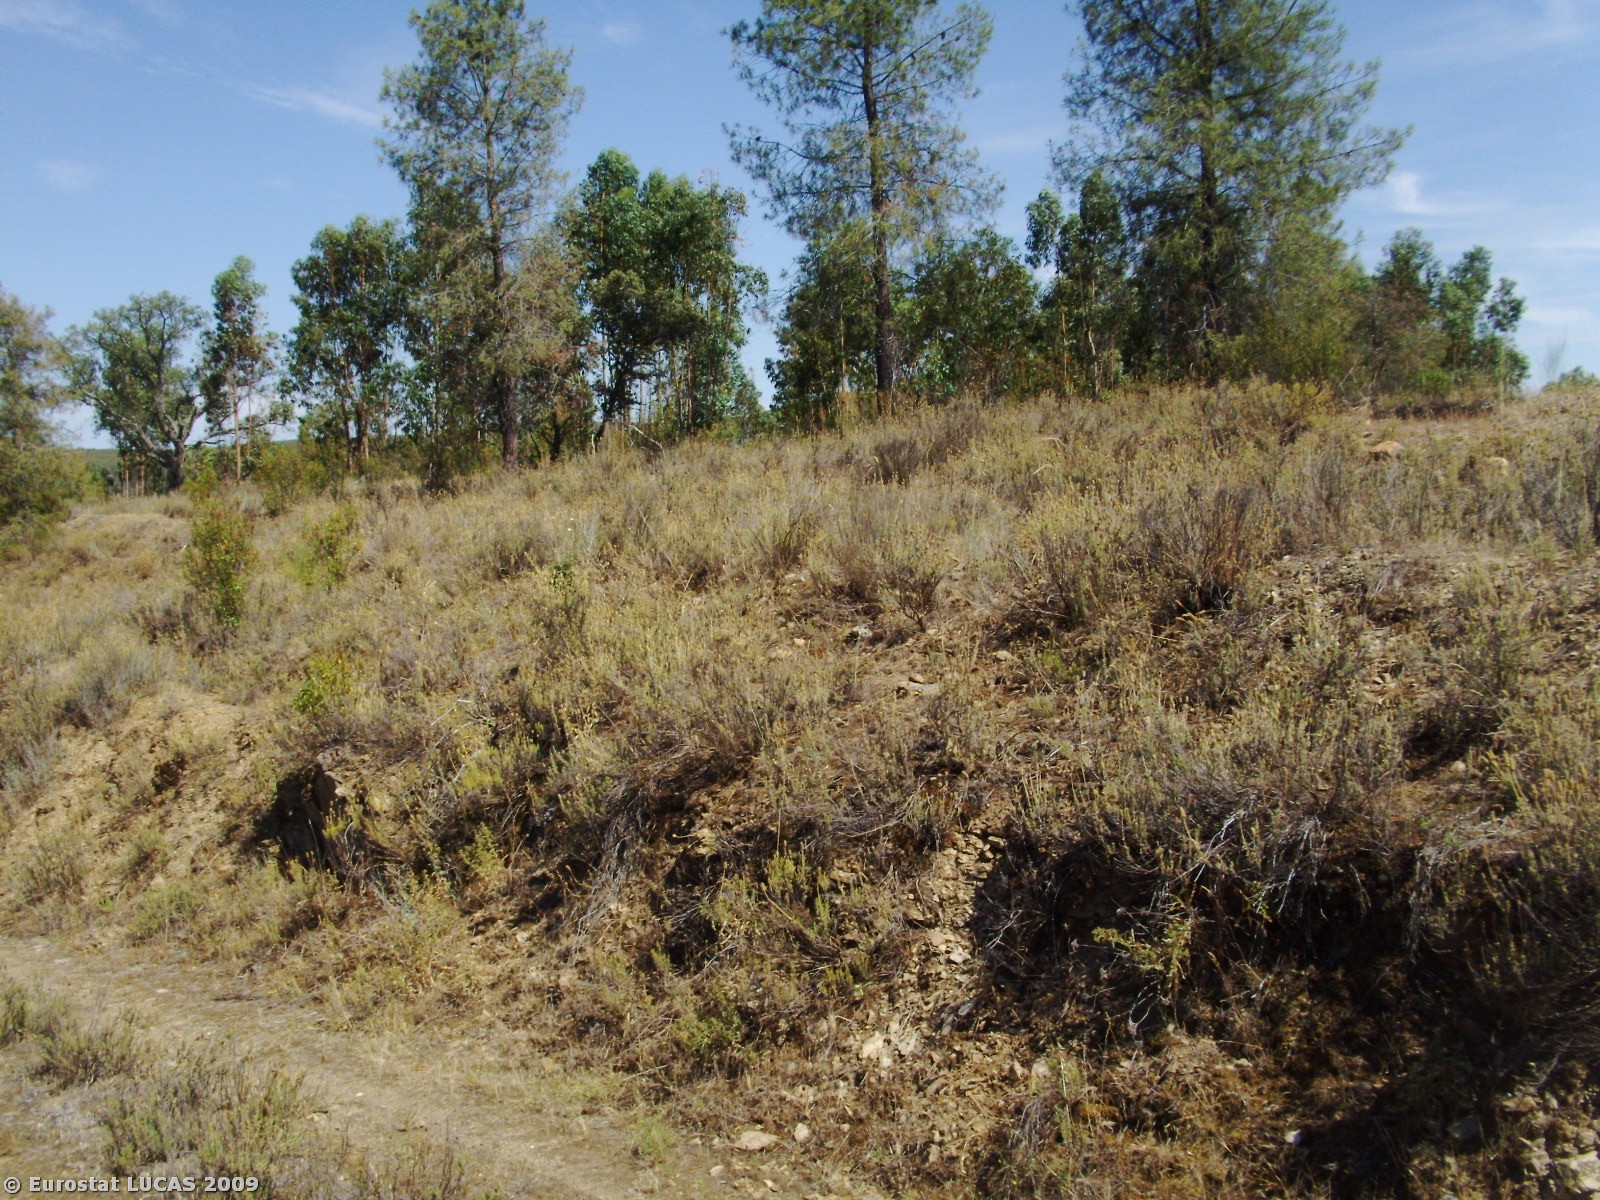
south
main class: Shrubland
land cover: Shrubland with sparse tree cover
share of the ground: 50 - 75 %
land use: Unused
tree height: > 5 m
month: July
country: PT
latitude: 40.0278
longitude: -6.8802
